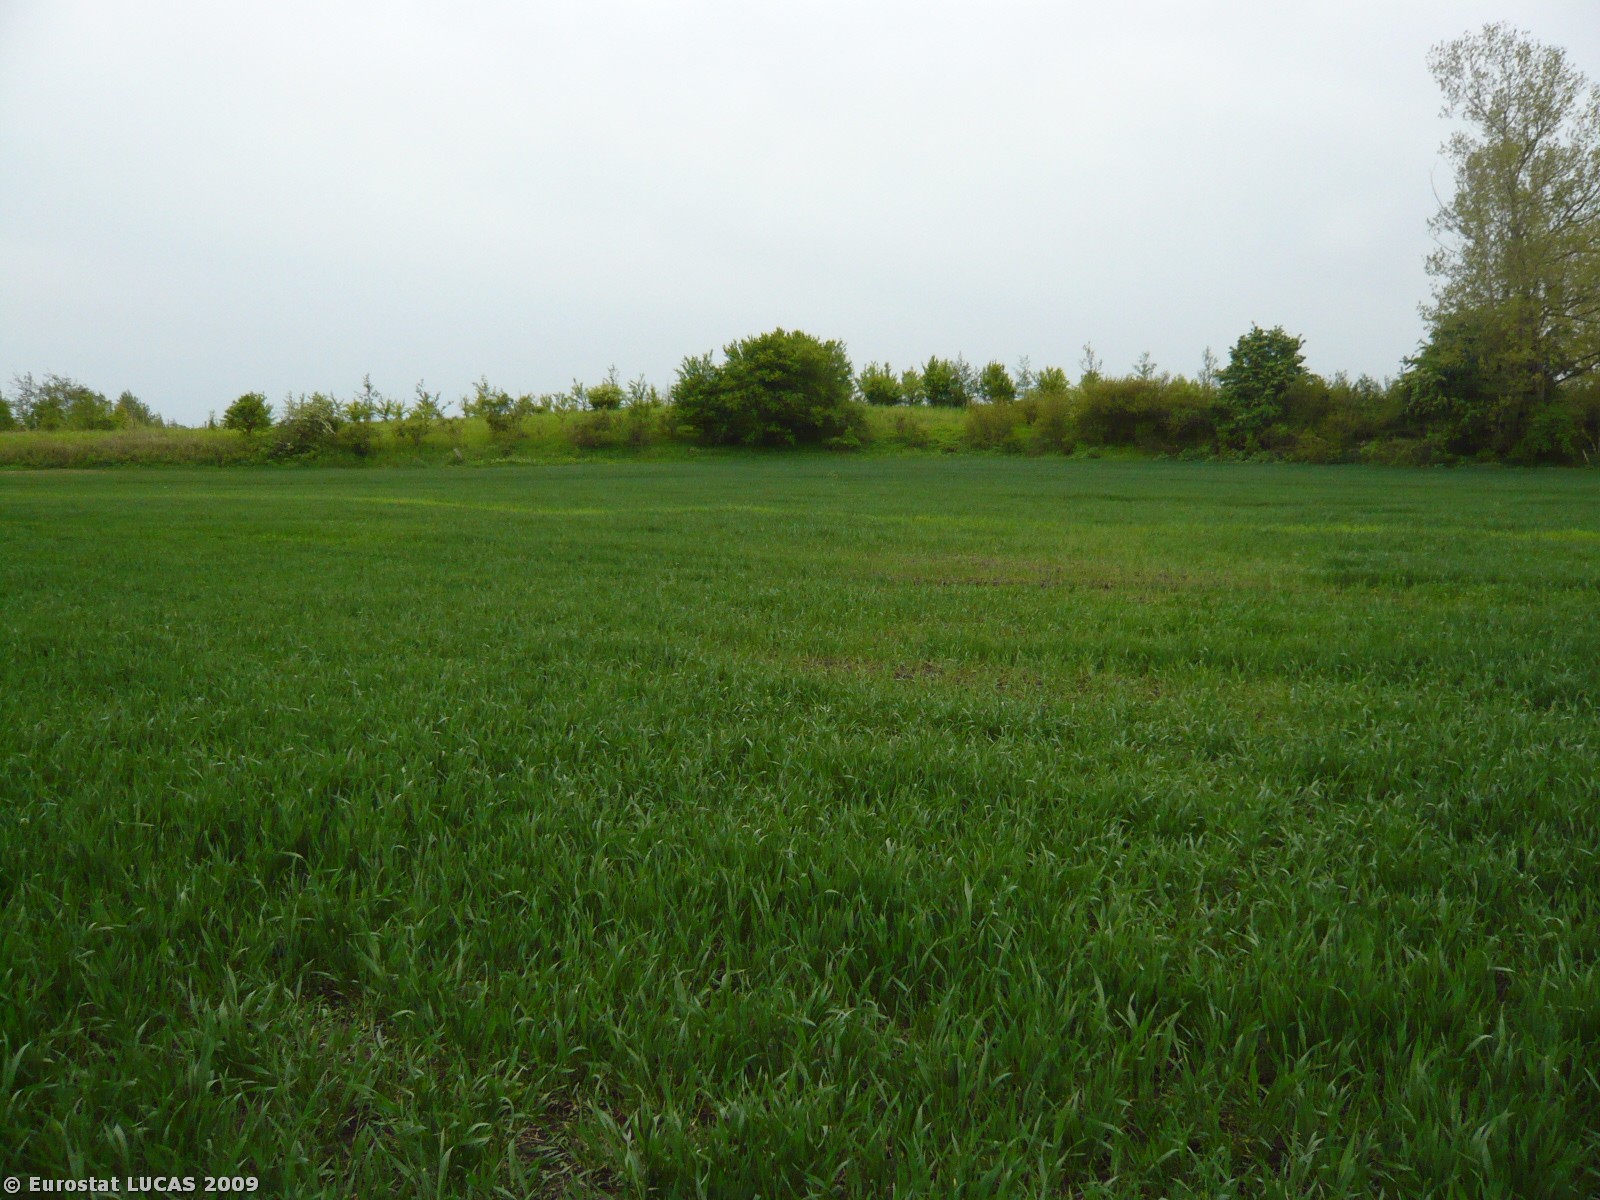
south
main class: Cropland
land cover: Common wheat
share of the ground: > 75 %
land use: Agriculture (excluding fallow land and kitchen gardens)
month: May
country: DK
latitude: 55.3990
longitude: 12.0038
